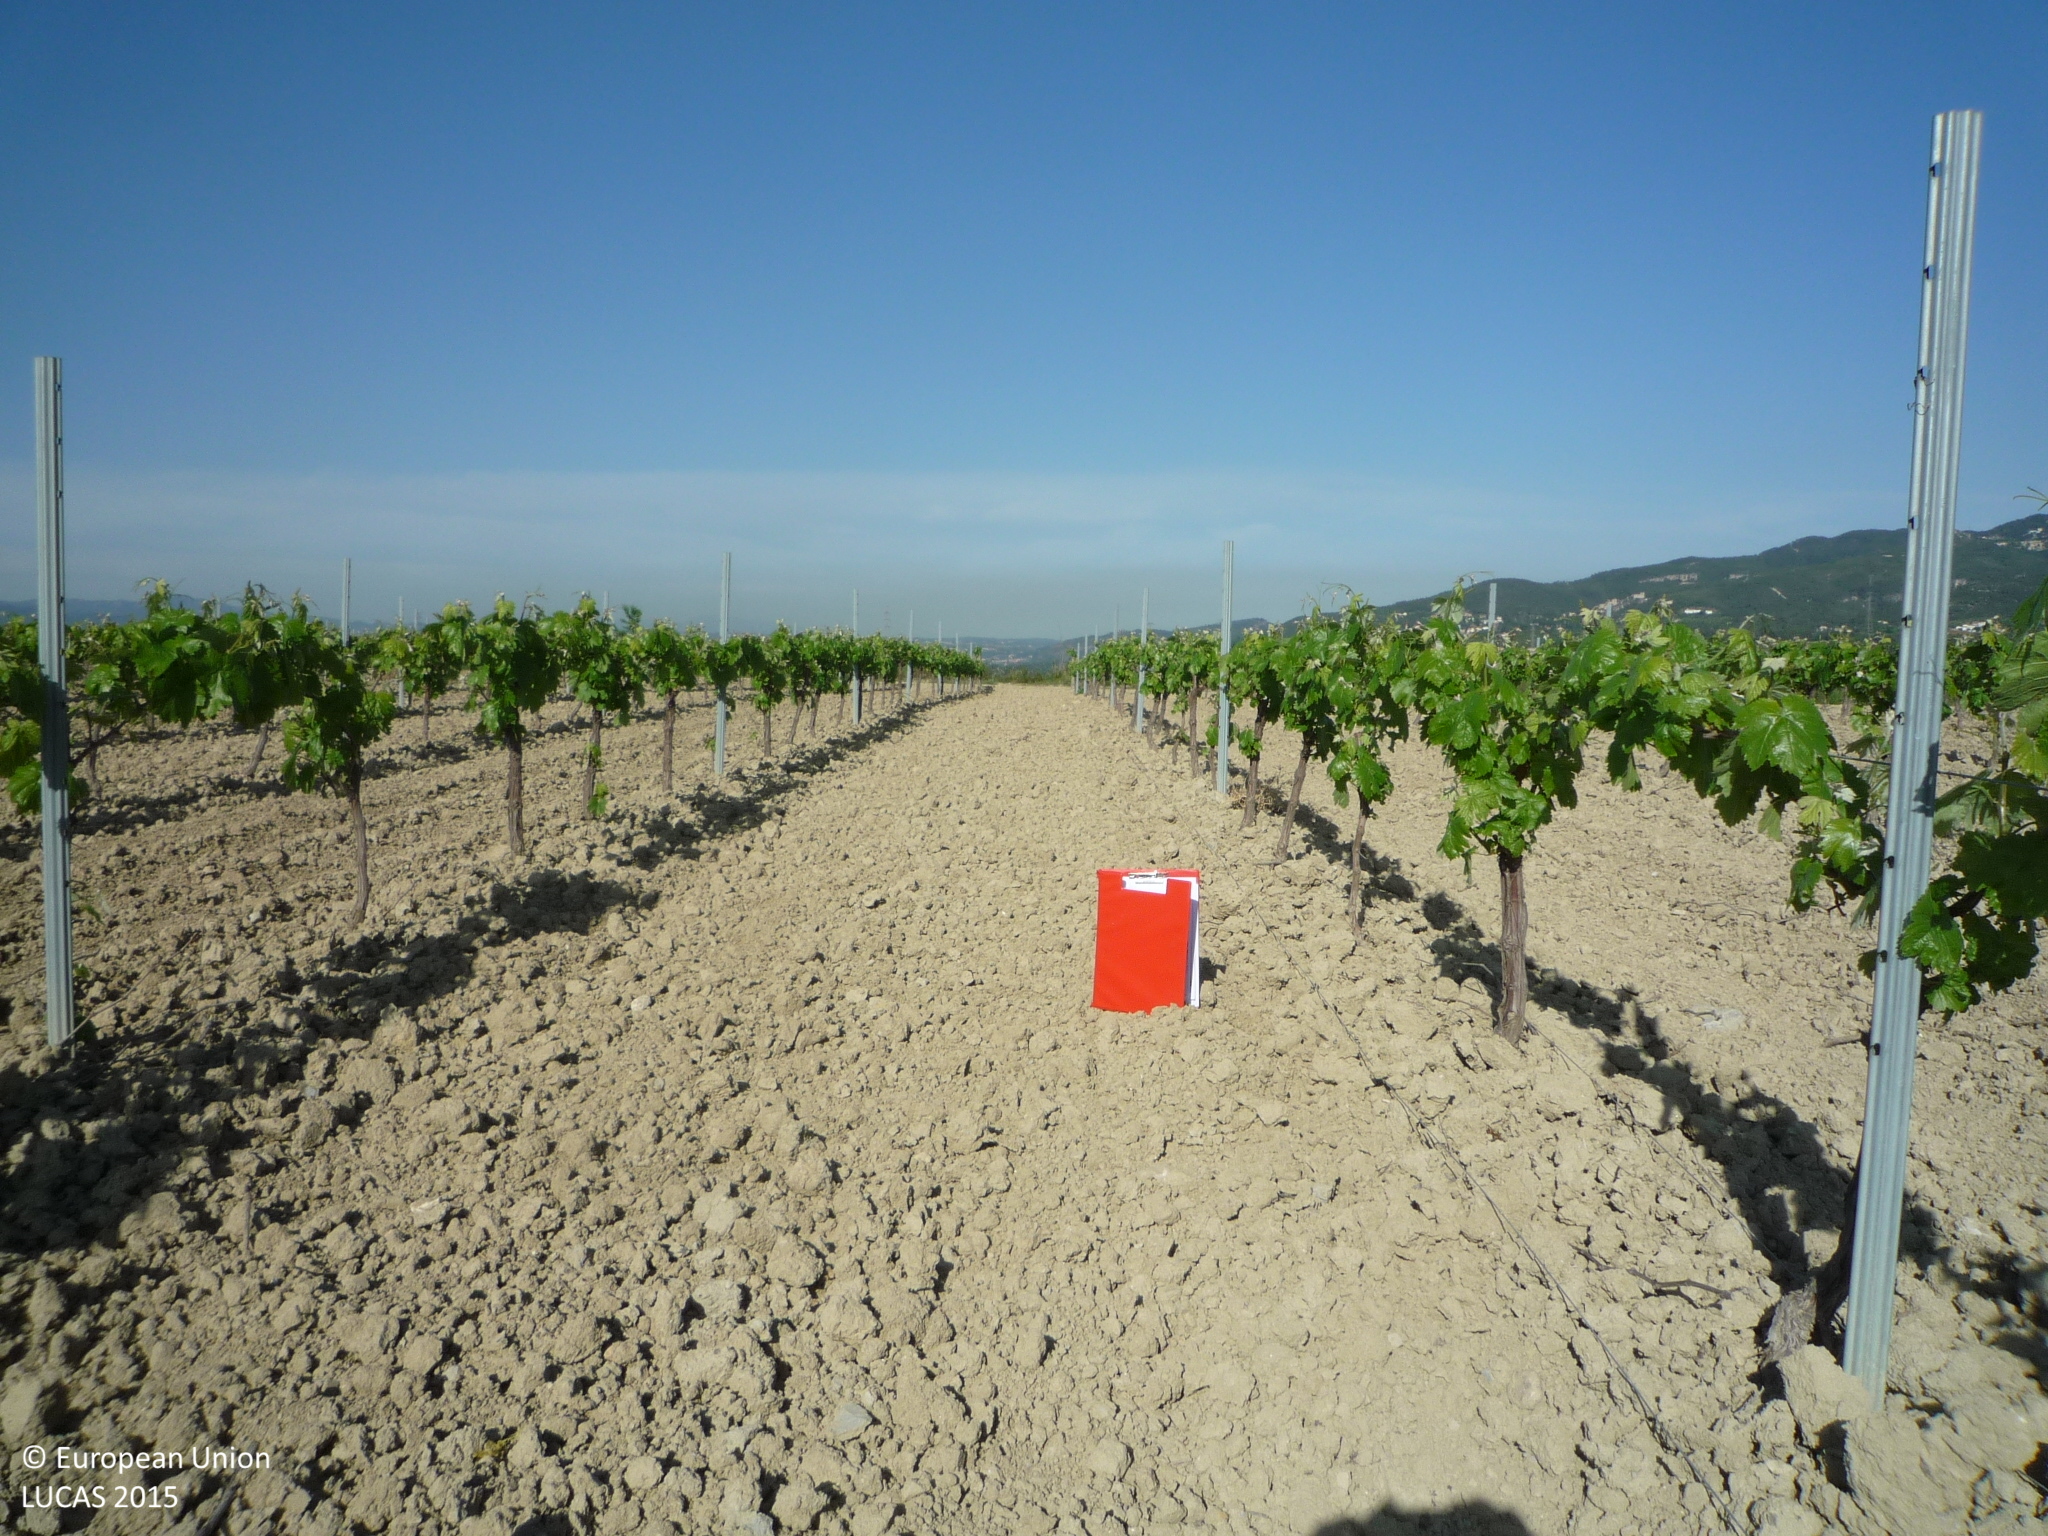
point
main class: Cropland
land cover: Vineyards
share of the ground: 10 - 25 %
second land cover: Other bare soil
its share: > 75 %
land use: Agriculture (excluding fallow land and kitchen gardens)
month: April
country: ES
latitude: 41.4333
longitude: 1.8196
